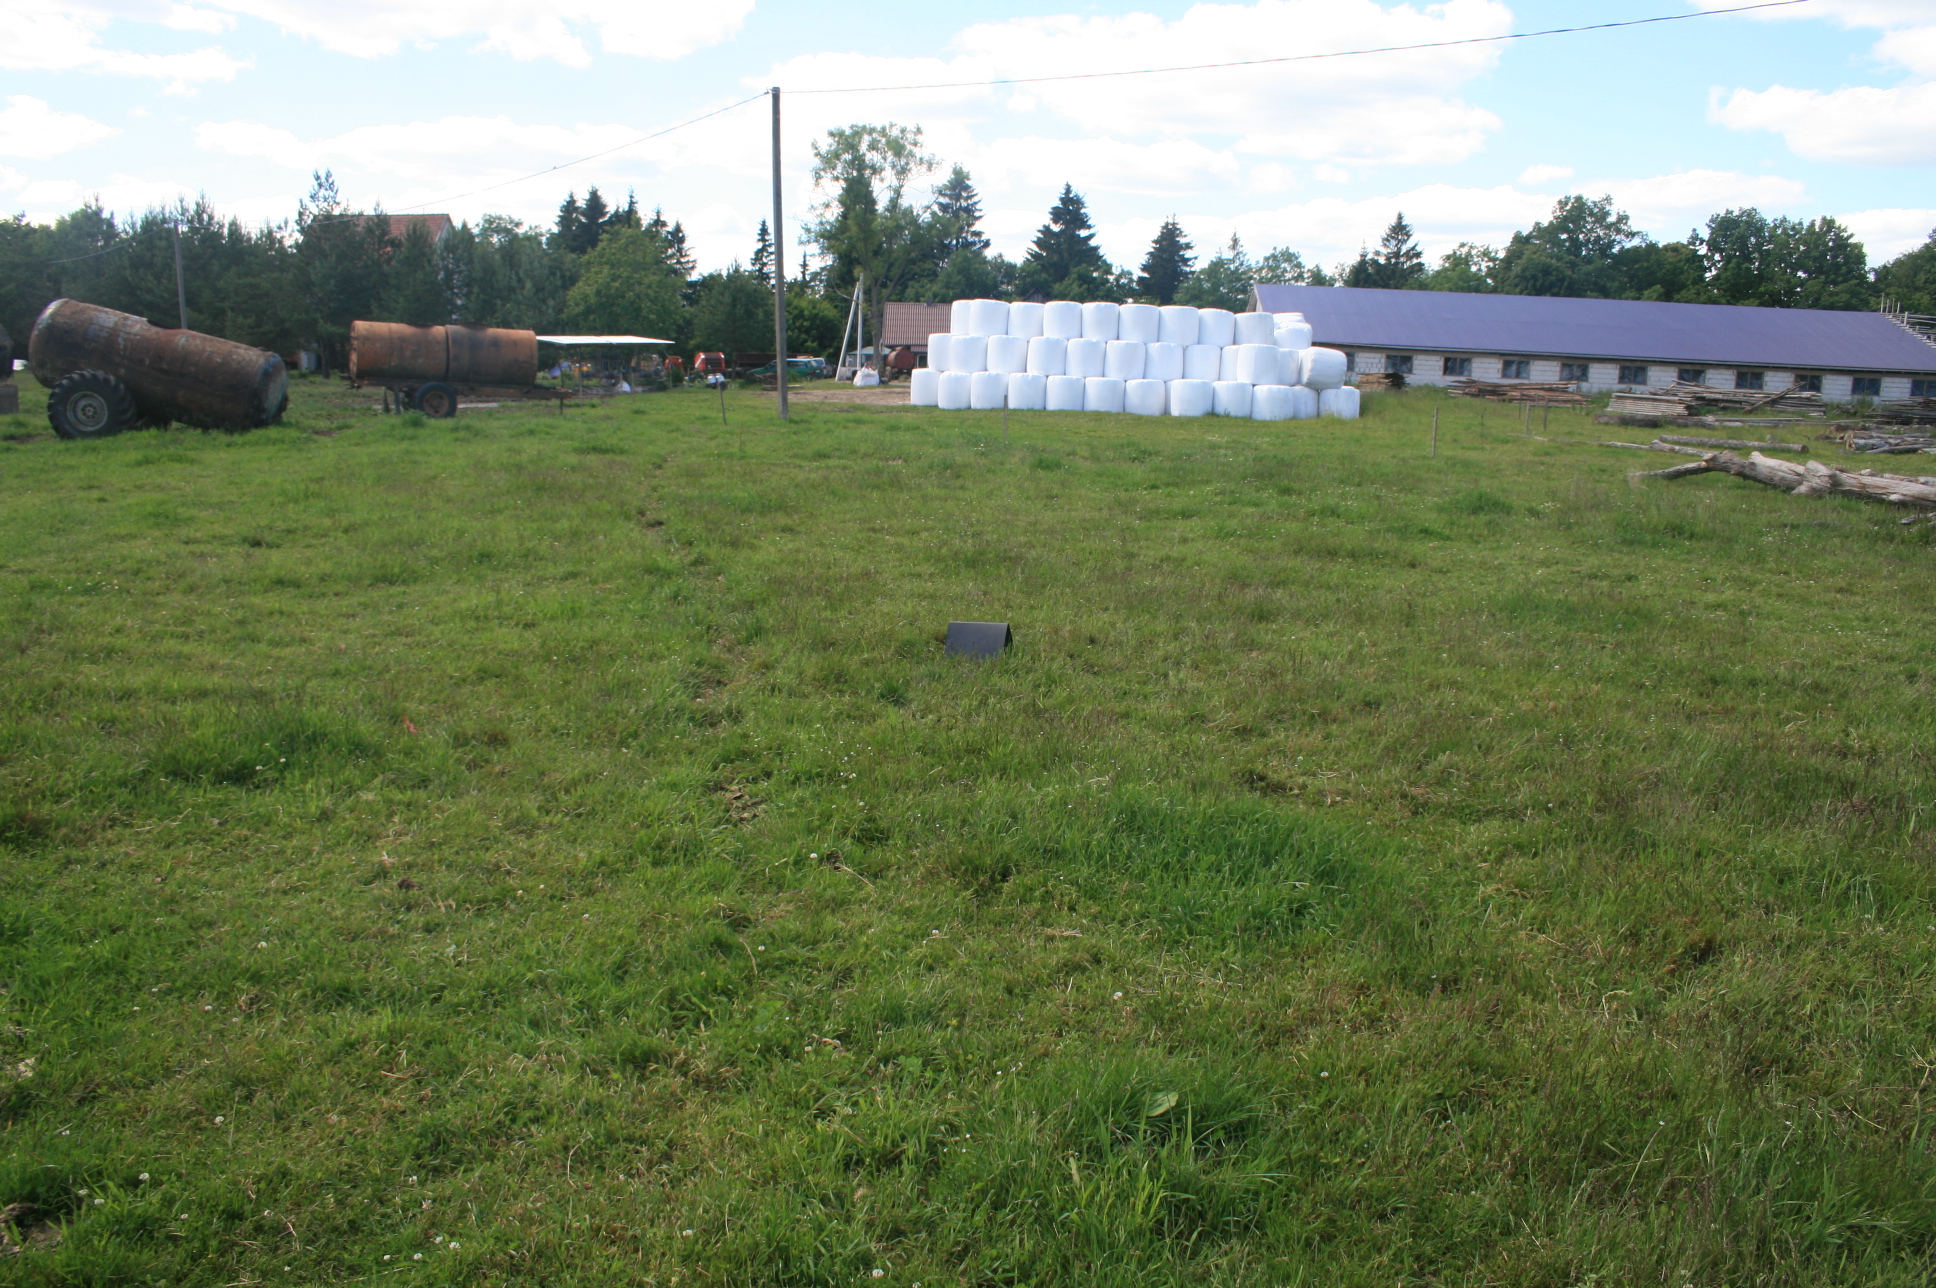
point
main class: Grassland
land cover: Grassland without tree/shrub cover
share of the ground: > 75 %
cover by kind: herbaceous plants 100 %
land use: Agriculture (excluding fallow land and kitchen gardens)
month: June
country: LT
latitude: 55.4177
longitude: 22.0445
